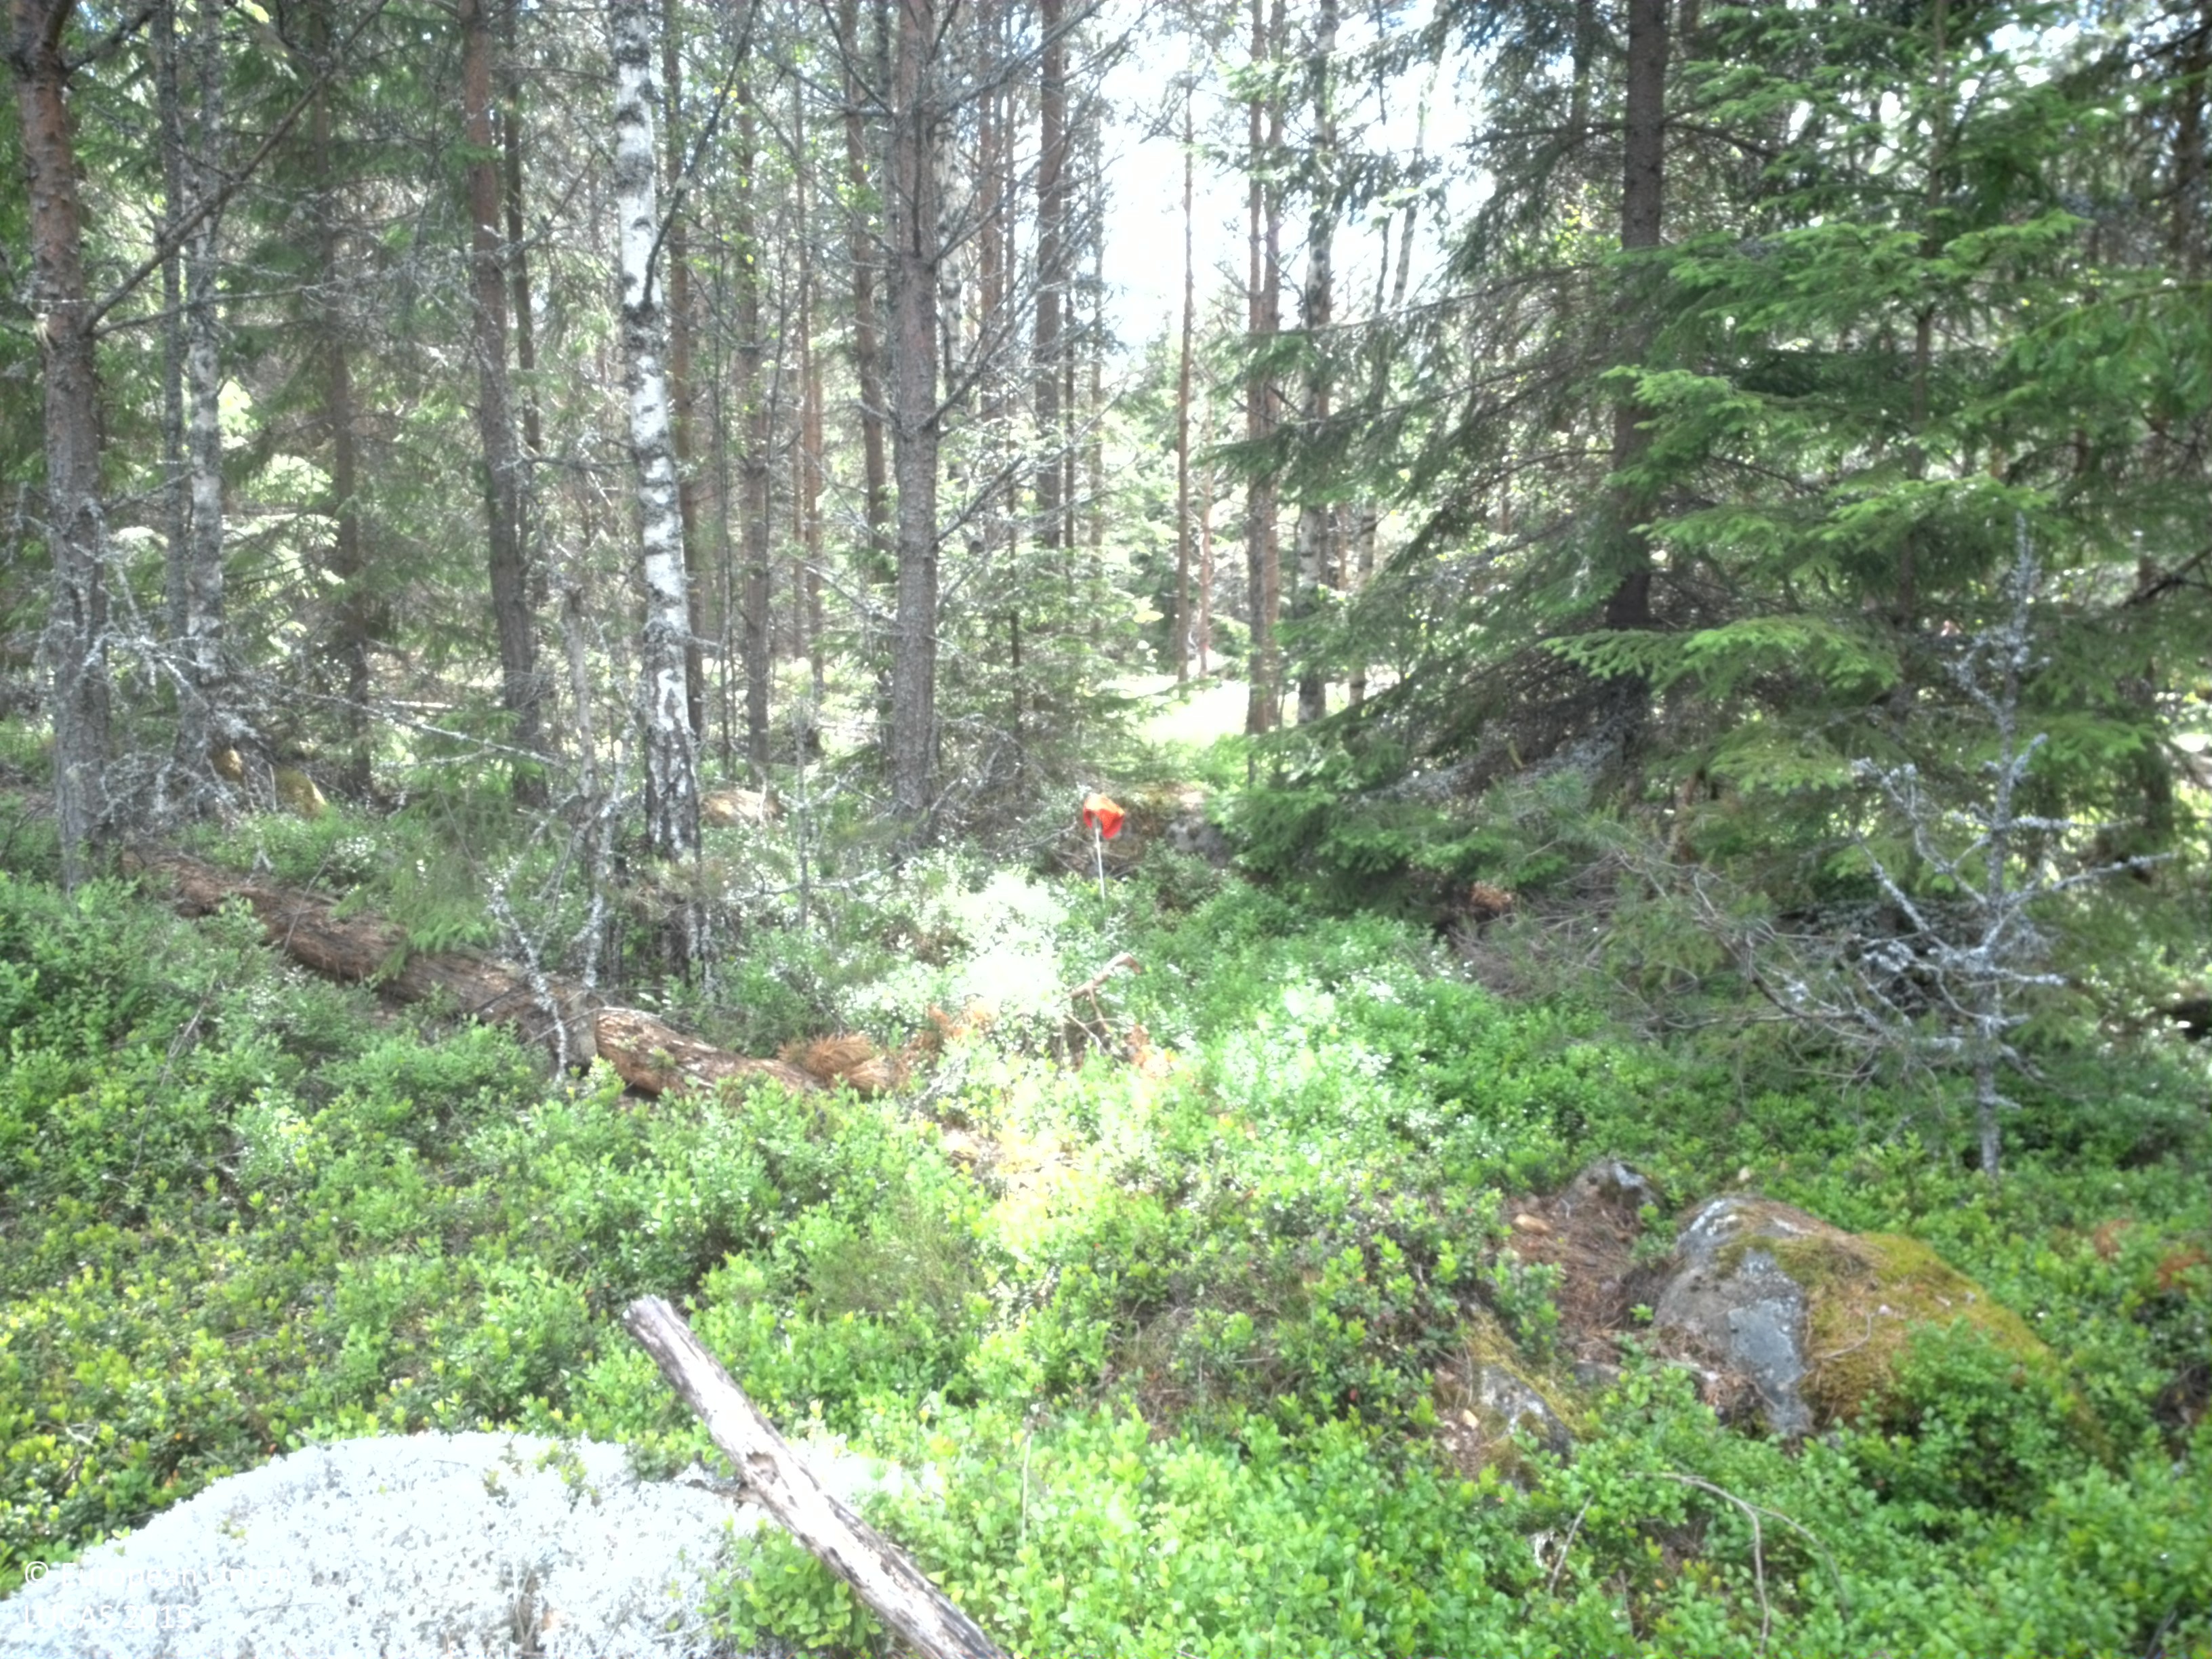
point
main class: Woodland
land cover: Pine dominated mixed woodland
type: boreal forest
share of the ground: 50 - 75 %
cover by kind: coniferous forest trees 40 %, herbaceous plants 35 %, broadleaved forest trees 15 %, lichens and mosses 10 %
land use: Forestry
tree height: > 5 m
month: June
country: SE
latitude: 58.6056
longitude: 15.6564
